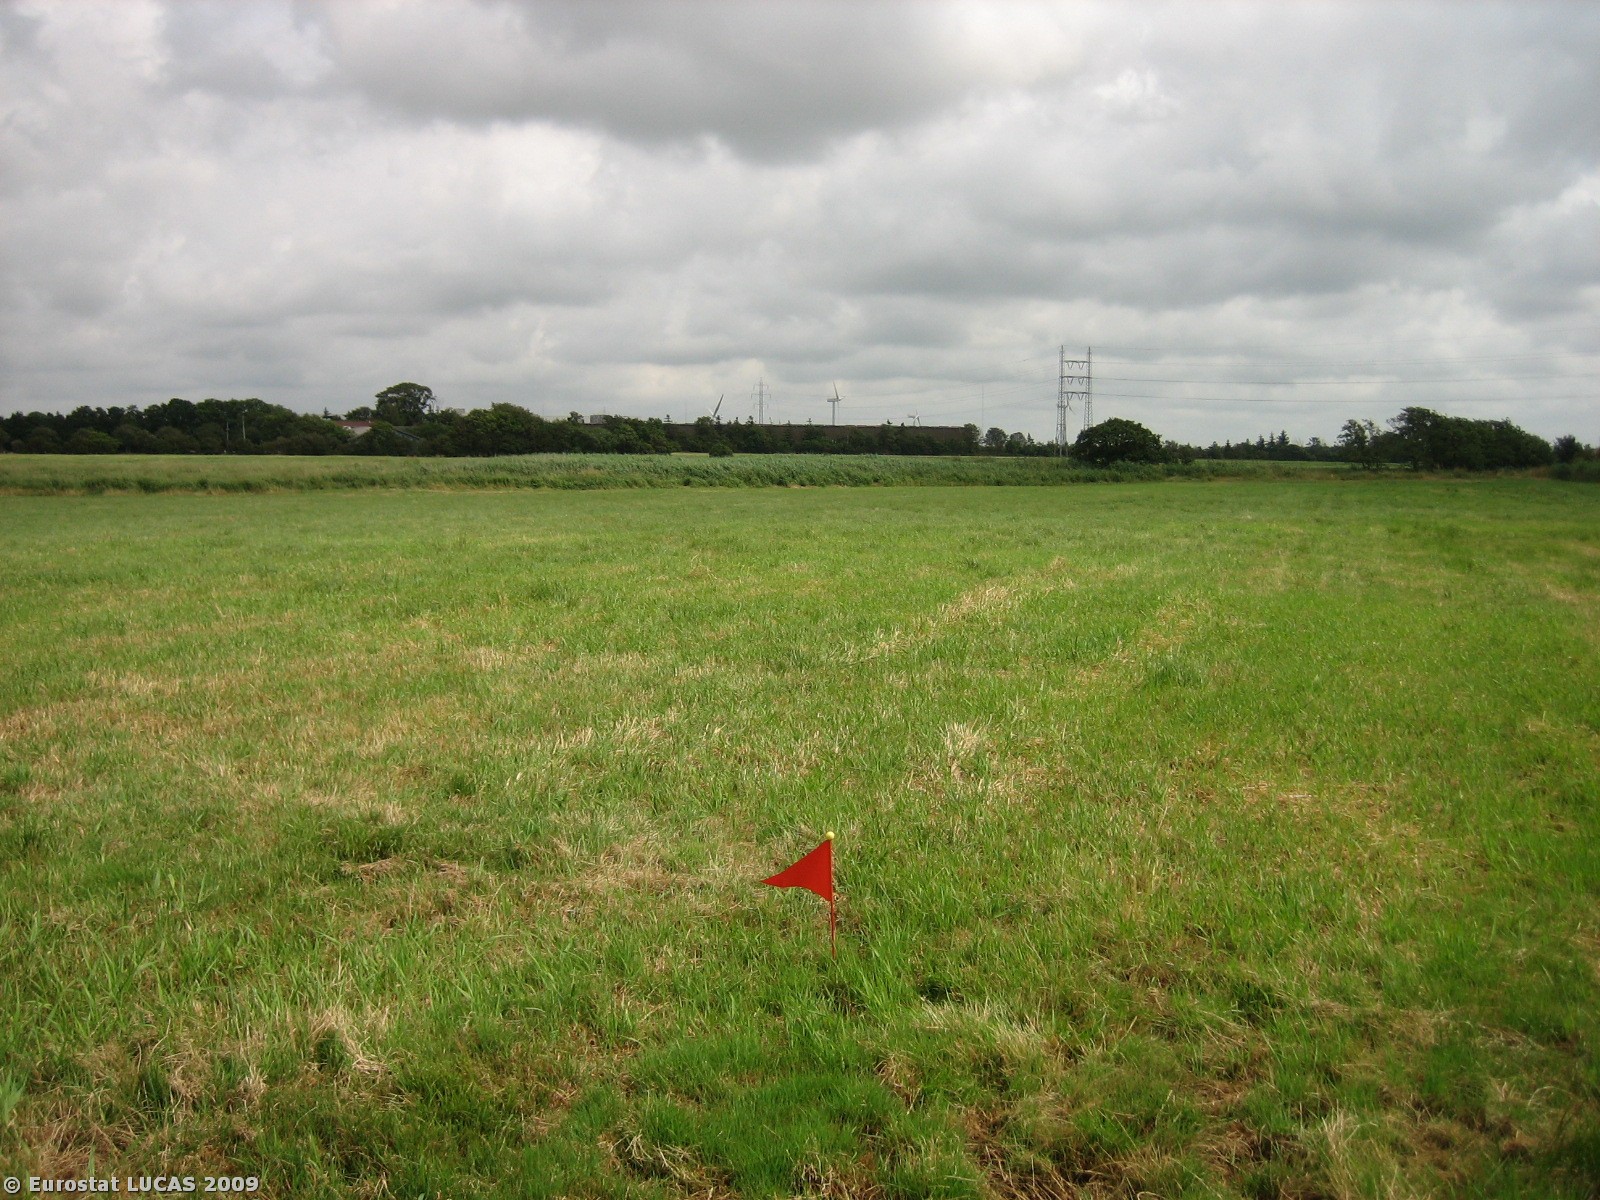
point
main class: Grassland
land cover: Grassland without tree/shrub cover
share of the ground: > 75 %
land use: Agriculture (excluding fallow land and kitchen gardens)
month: July
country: DK
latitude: 55.4606
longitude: 8.5621
